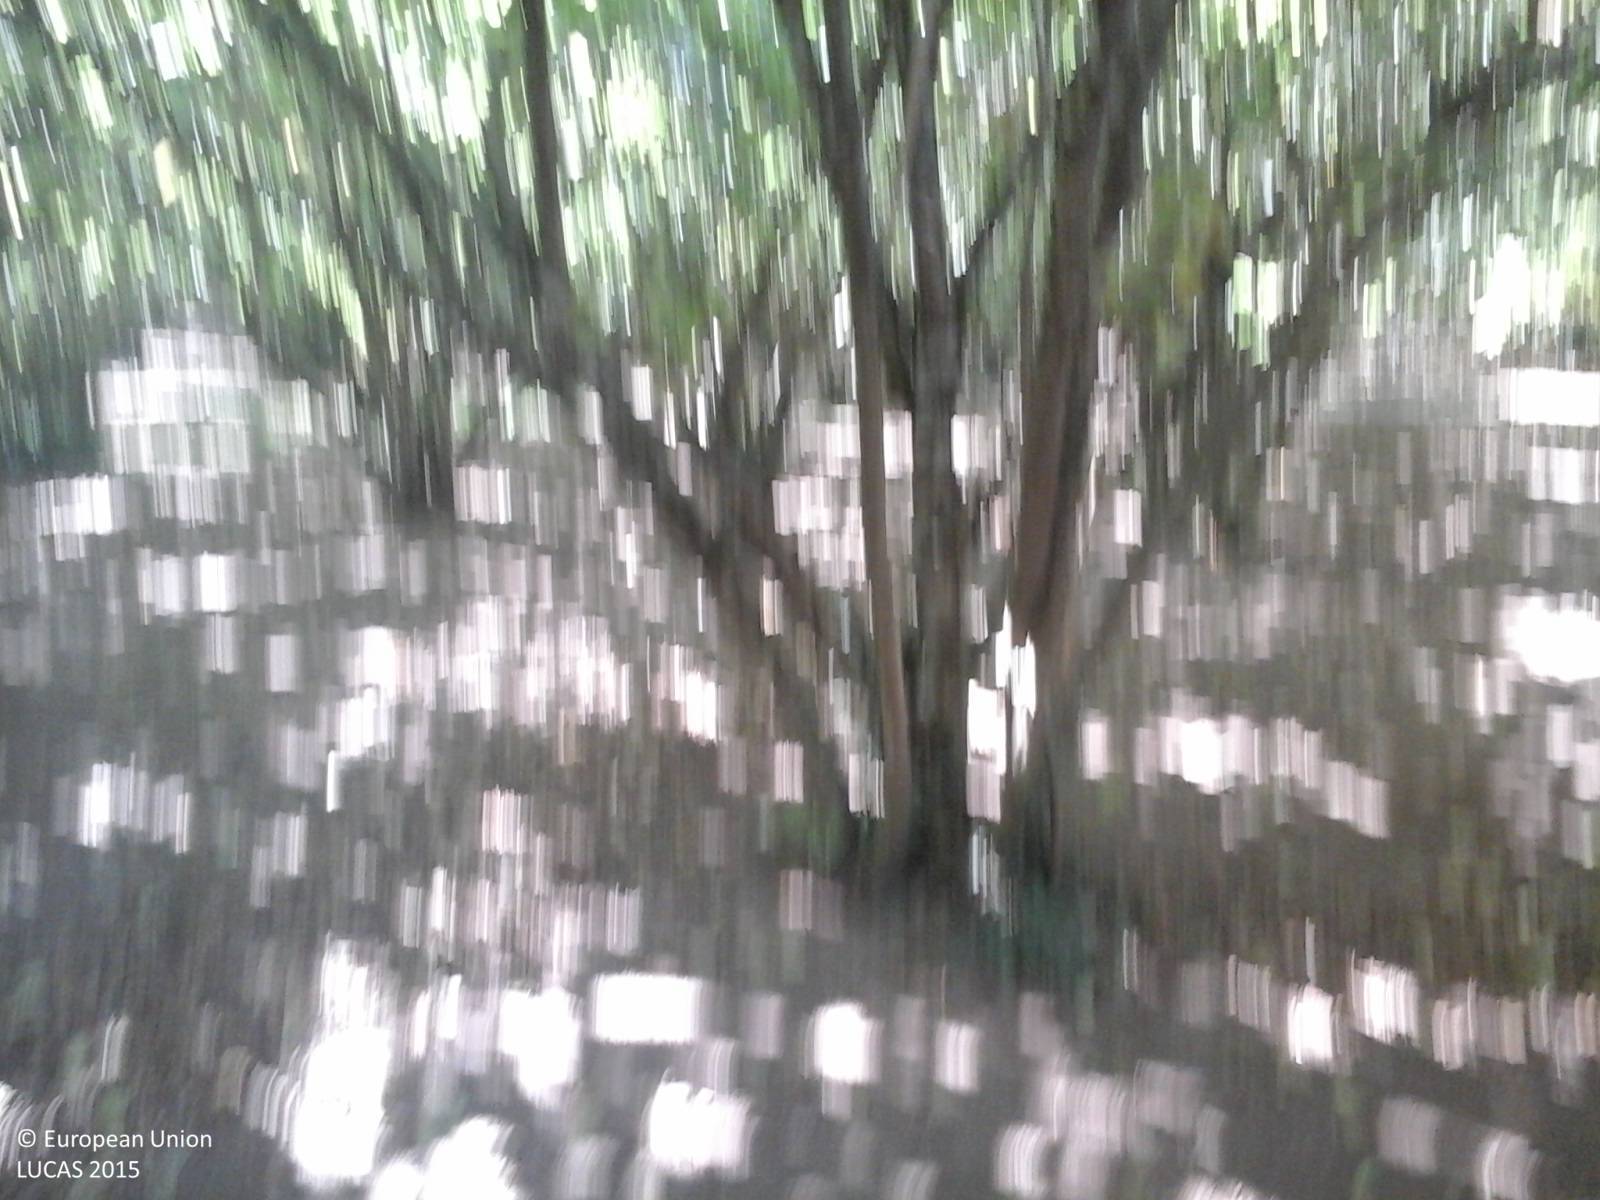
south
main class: Cropland
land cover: Nuts trees
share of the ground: > 75 %
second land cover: Other bare soil
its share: > 75 %
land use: Agriculture (excluding fallow land and kitchen gardens)
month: September
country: IT
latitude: 42.3752
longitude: 12.2875
